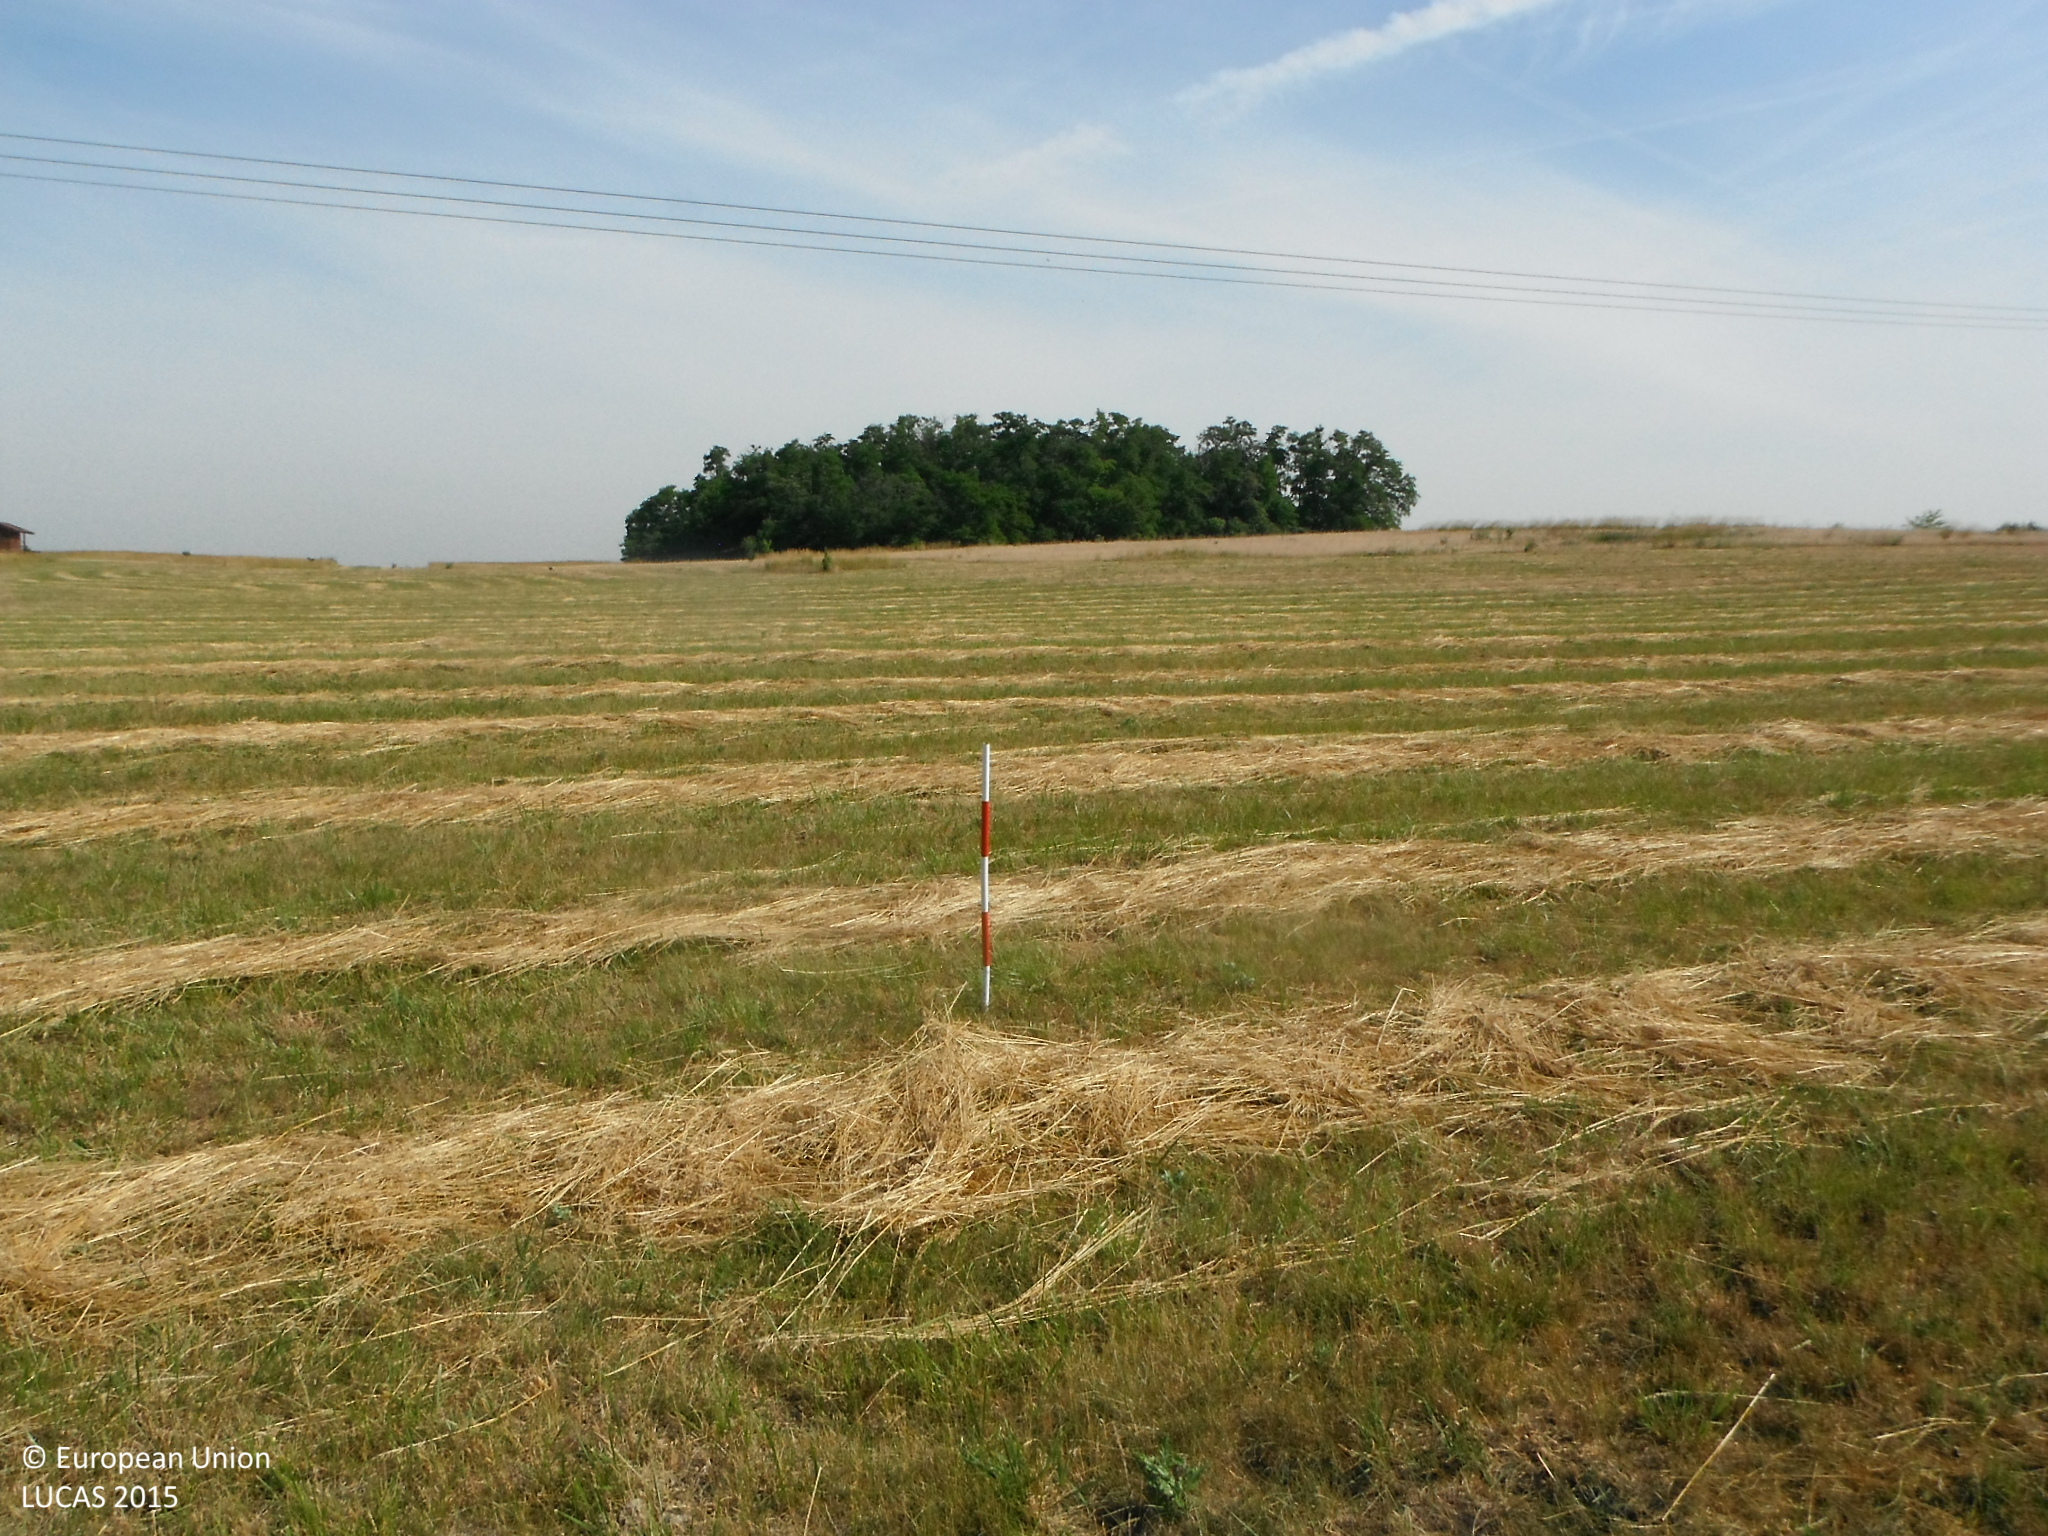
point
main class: Grassland
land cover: Grassland without tree/shrub cover
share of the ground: > 75 %
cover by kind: herbaceous plants 100 %
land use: Agriculture (excluding fallow land and kitchen gardens)
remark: Harvested field
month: June
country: SK
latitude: 48.1961
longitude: 17.8554
